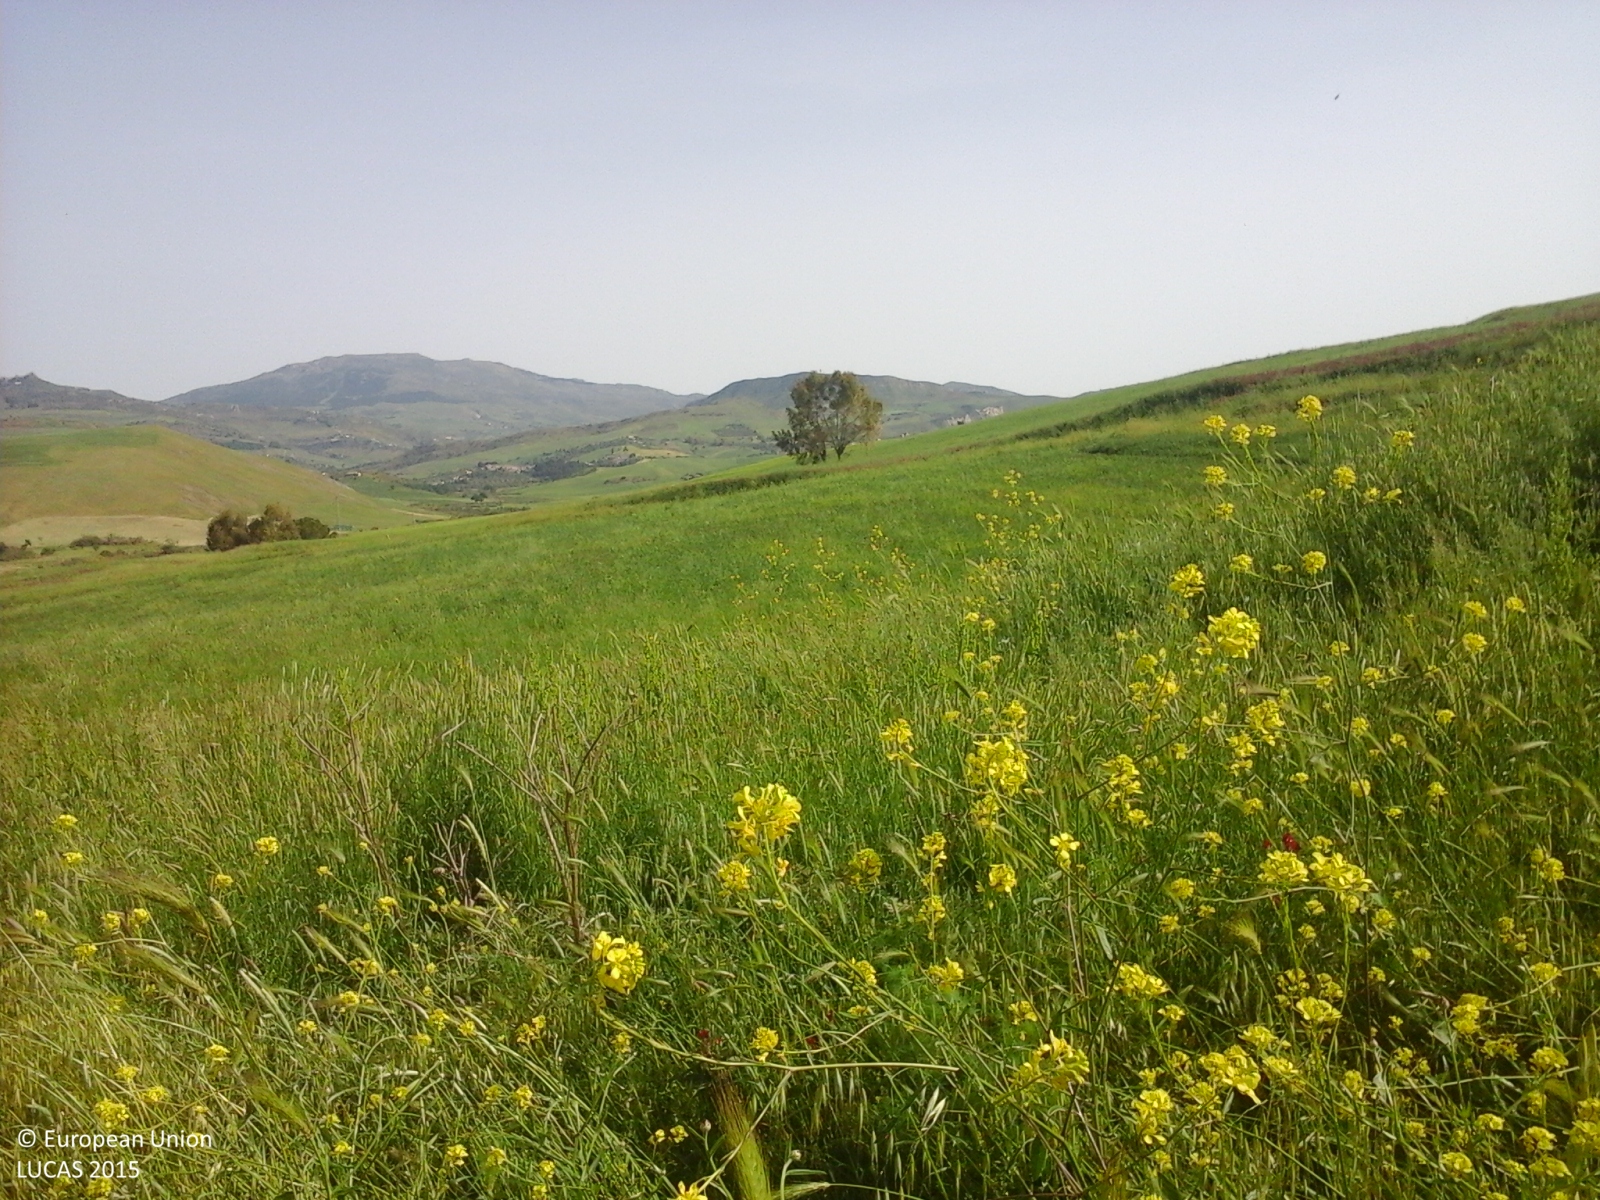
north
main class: Cropland
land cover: Temporary grasslands
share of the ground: > 75 %
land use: Agriculture (excluding fallow land and kitchen gardens)
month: May
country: IT
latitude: 37.7303
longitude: 14.1344
